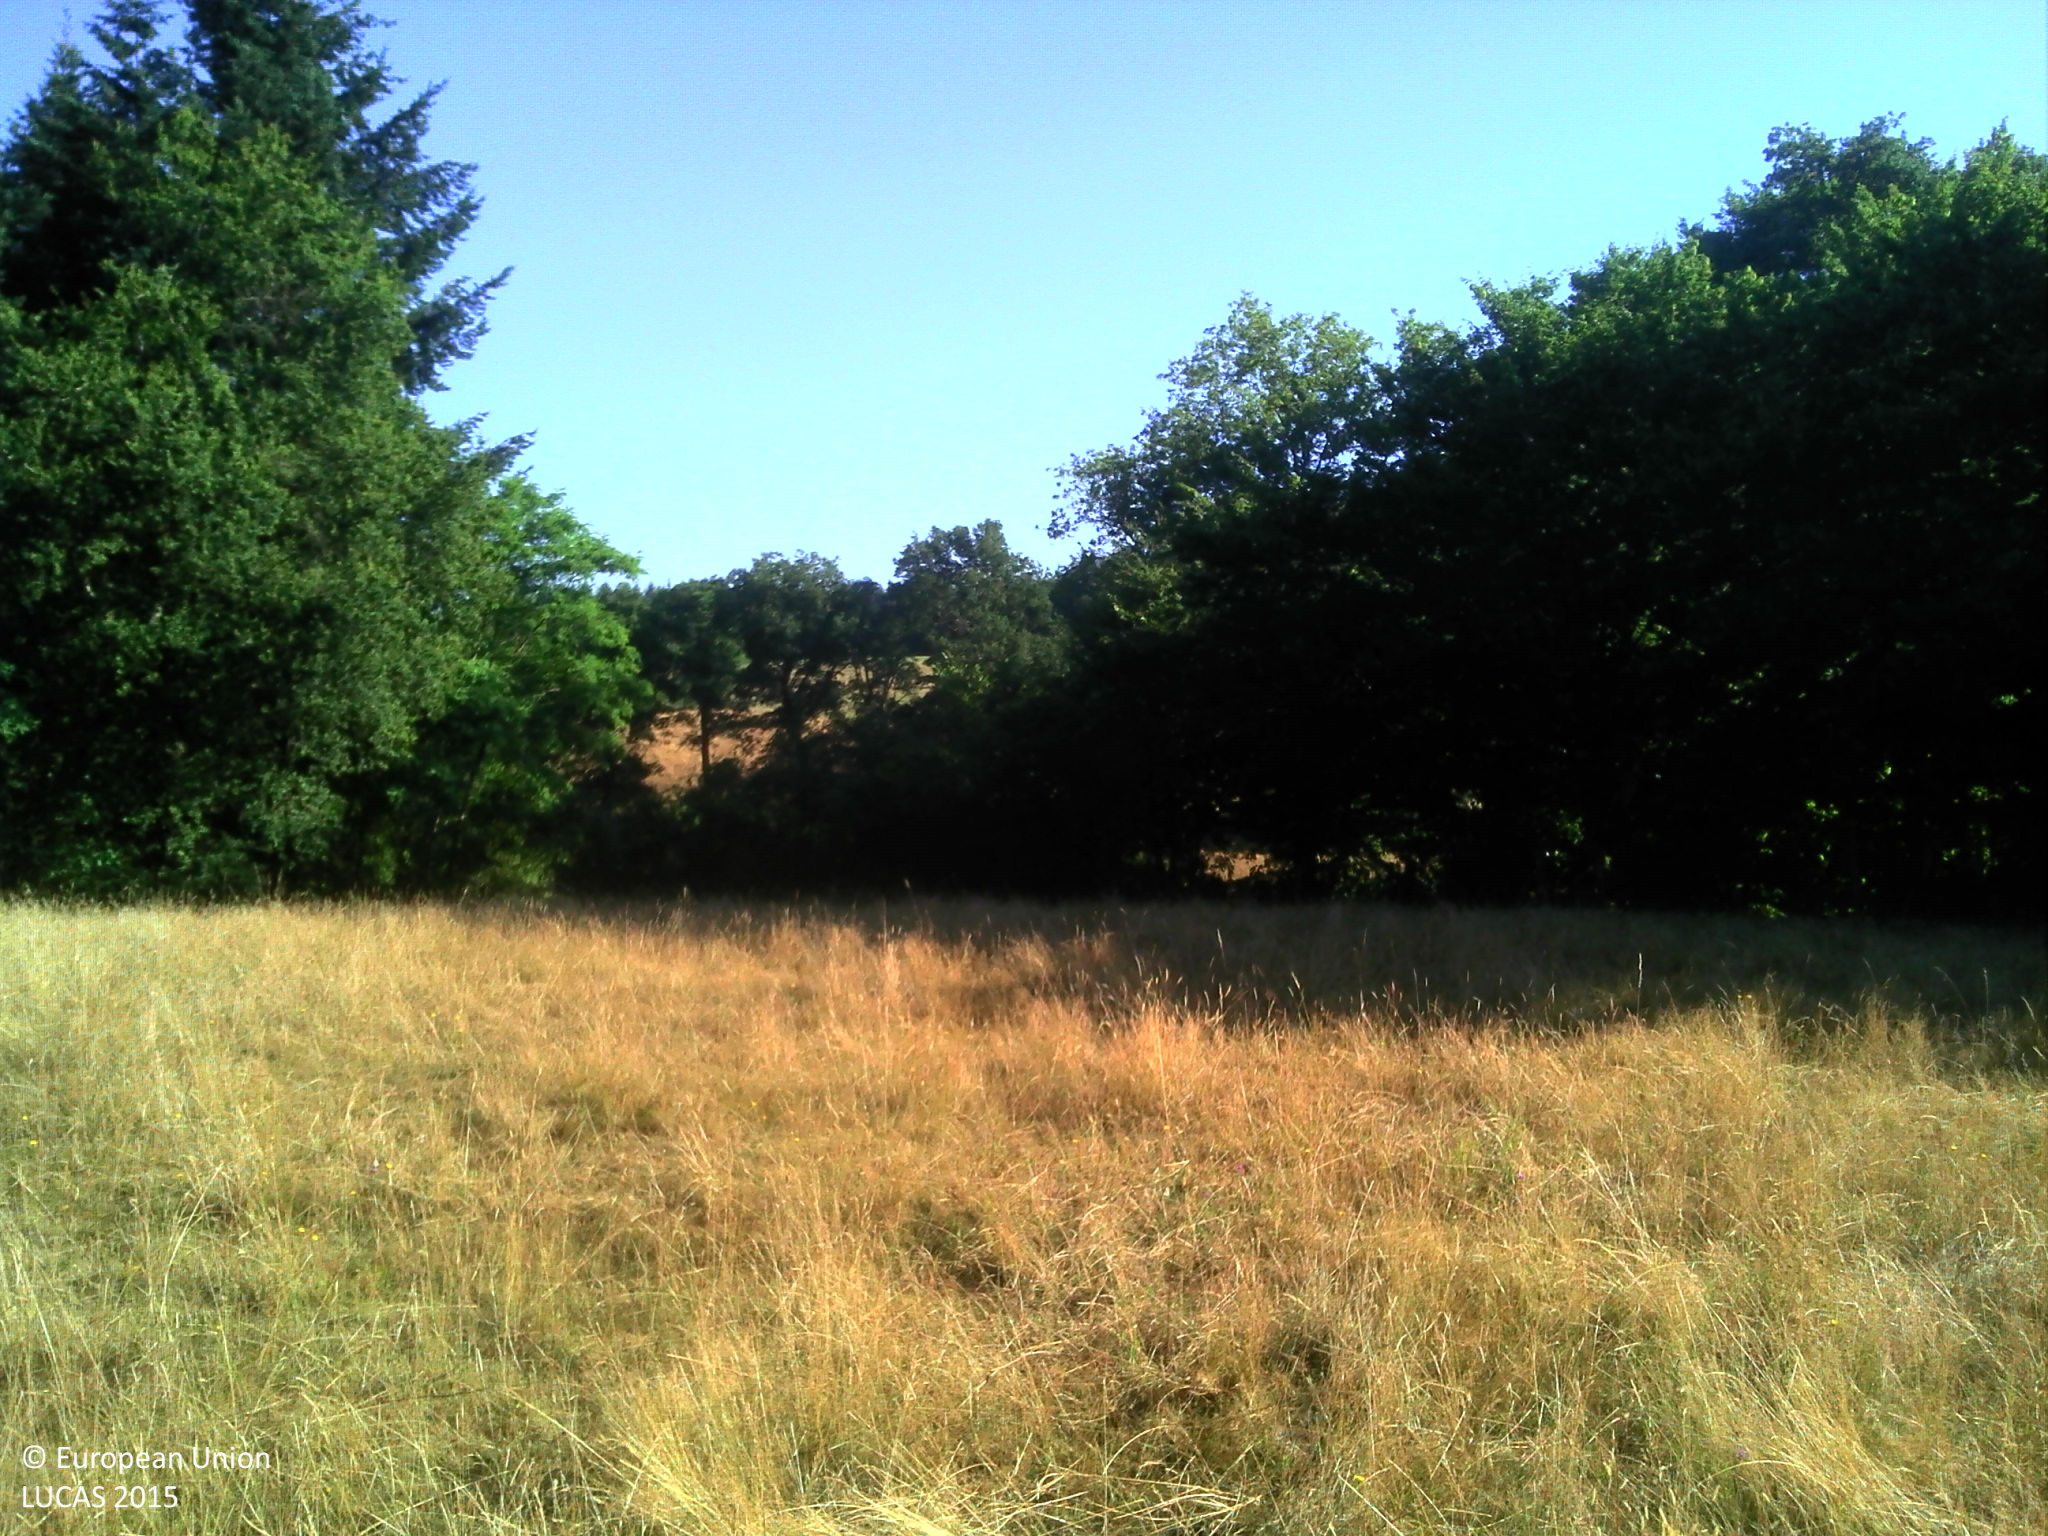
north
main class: Grassland
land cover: Grassland without tree/shrub cover
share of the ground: > 75 %
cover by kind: herbaceous plants 100 %
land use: Agriculture (excluding fallow land and kitchen gardens)
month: June
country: FR
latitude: 46.4055
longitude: 4.4471
